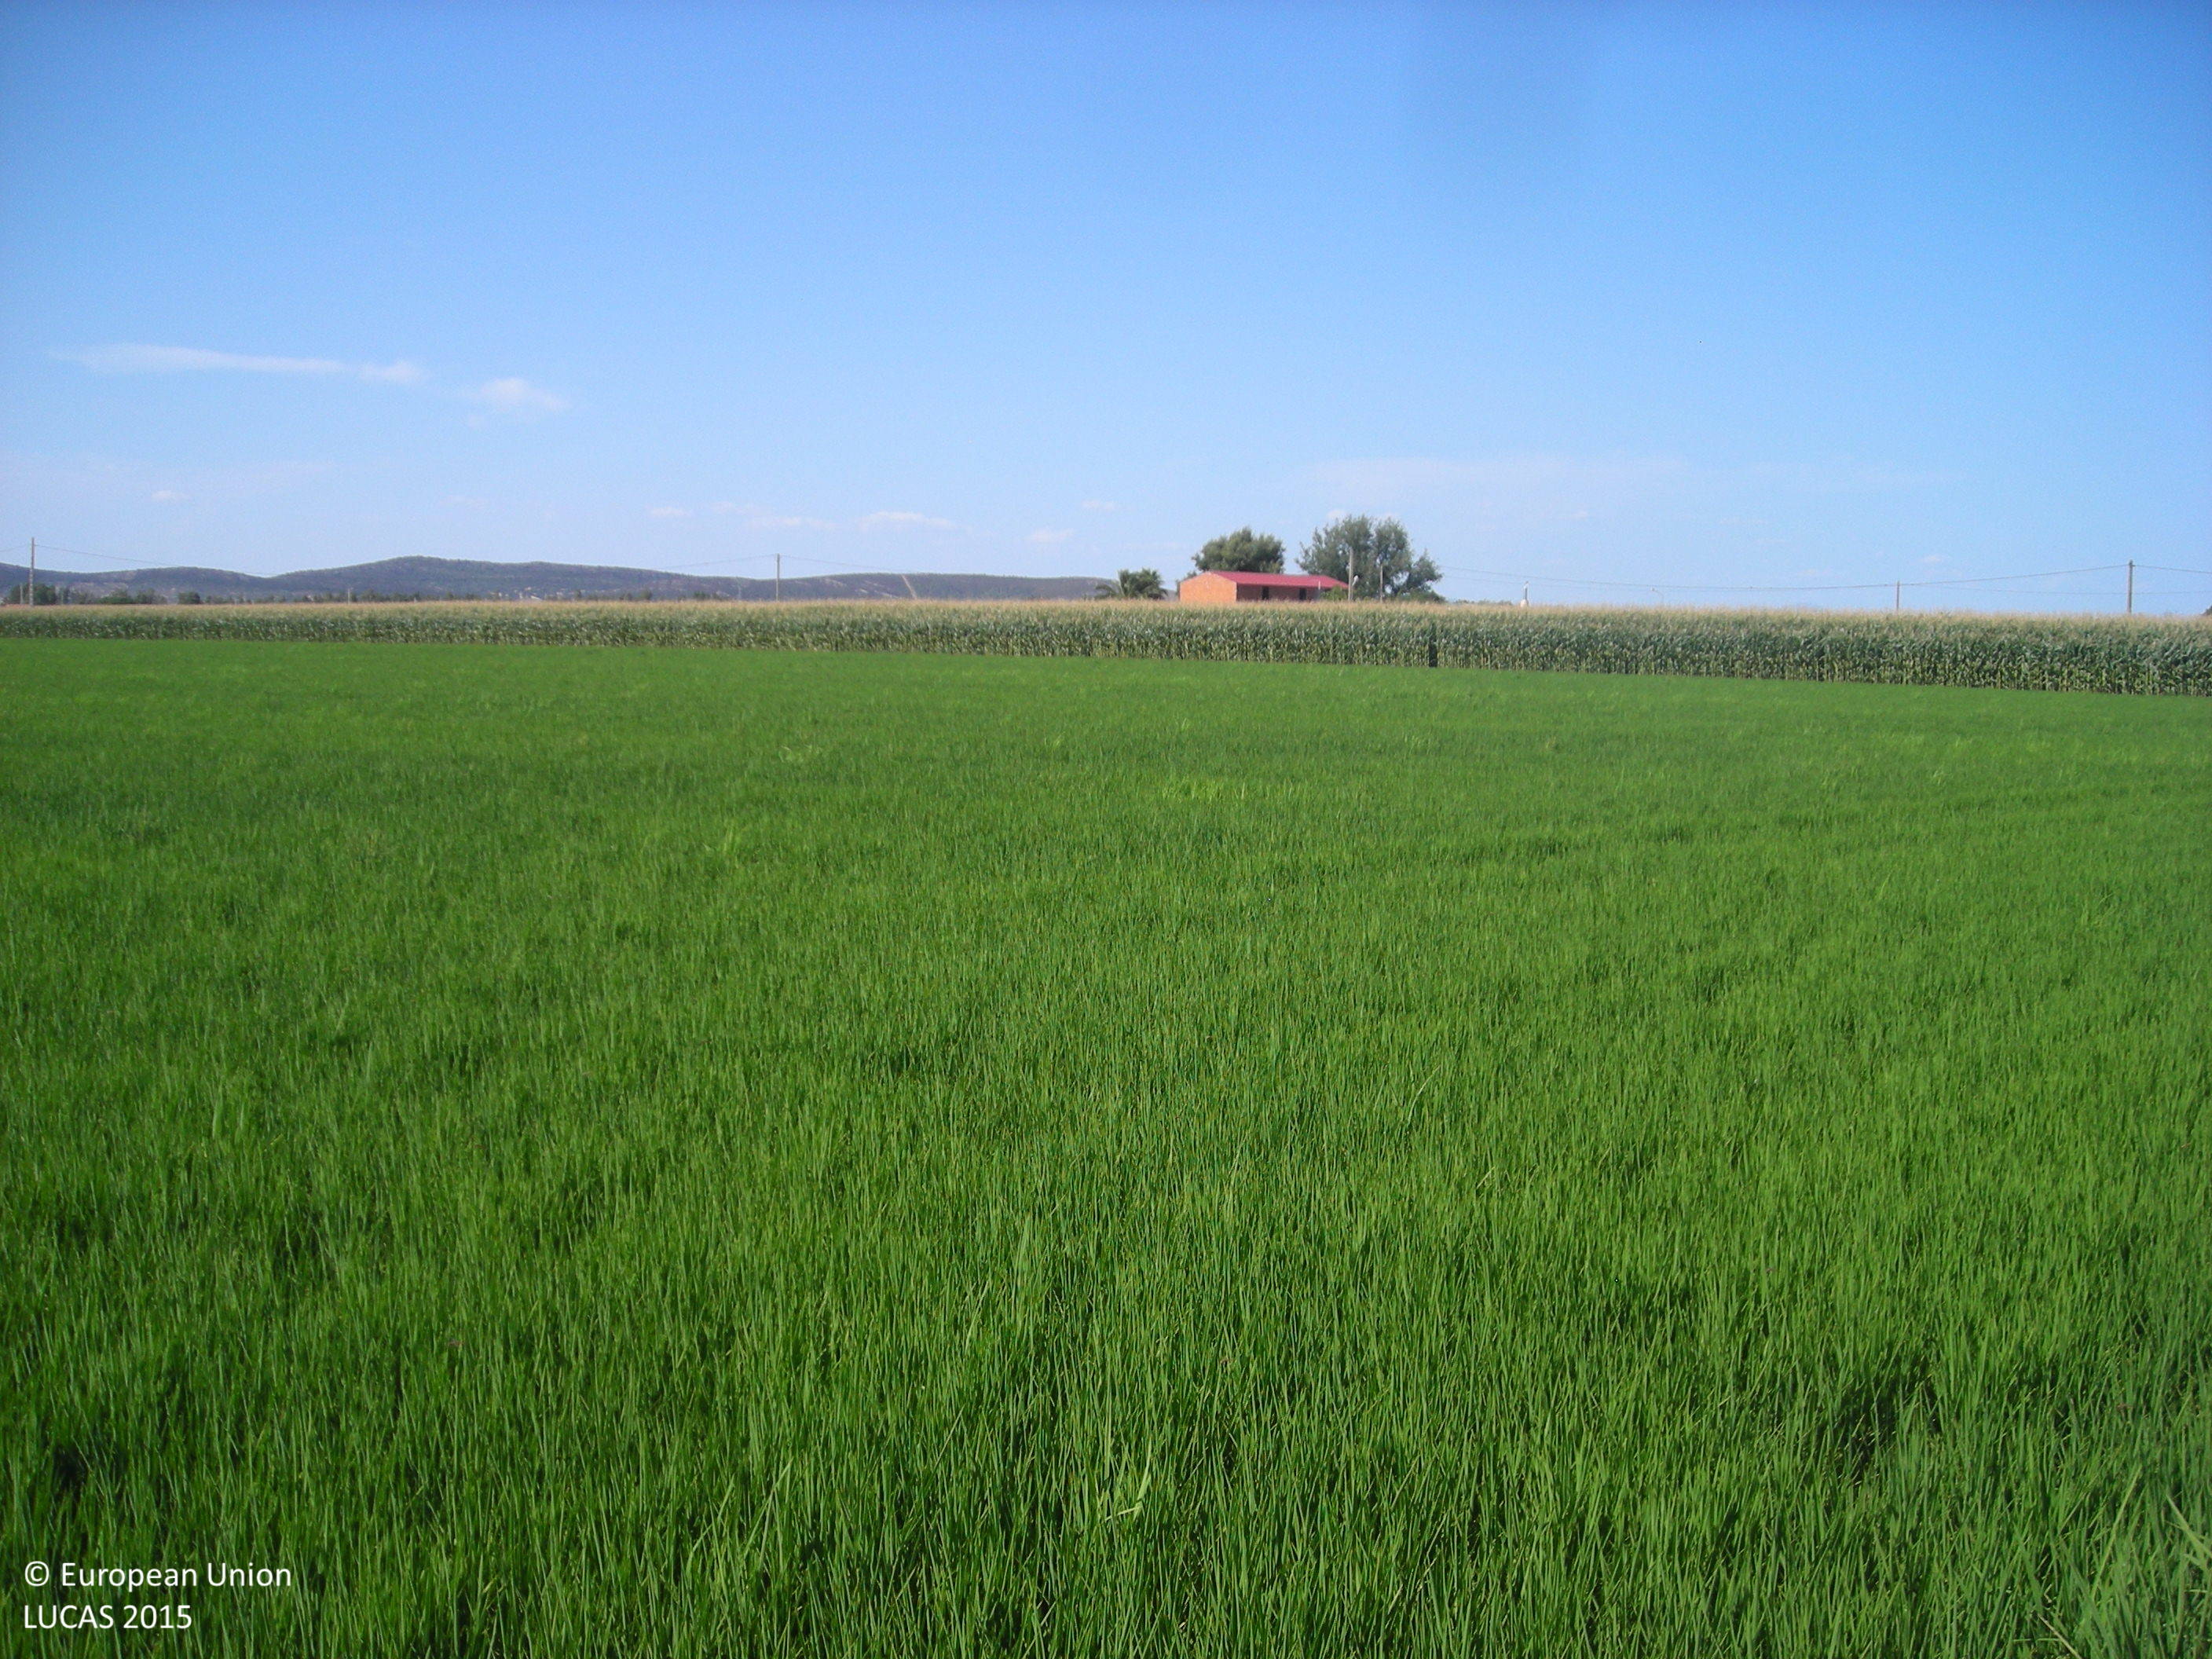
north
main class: Cropland
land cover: Tomatoes
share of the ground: > 75 %
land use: Agriculture (excluding fallow land and kitchen gardens)
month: July
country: ES
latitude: 39.0088
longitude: -5.8361
